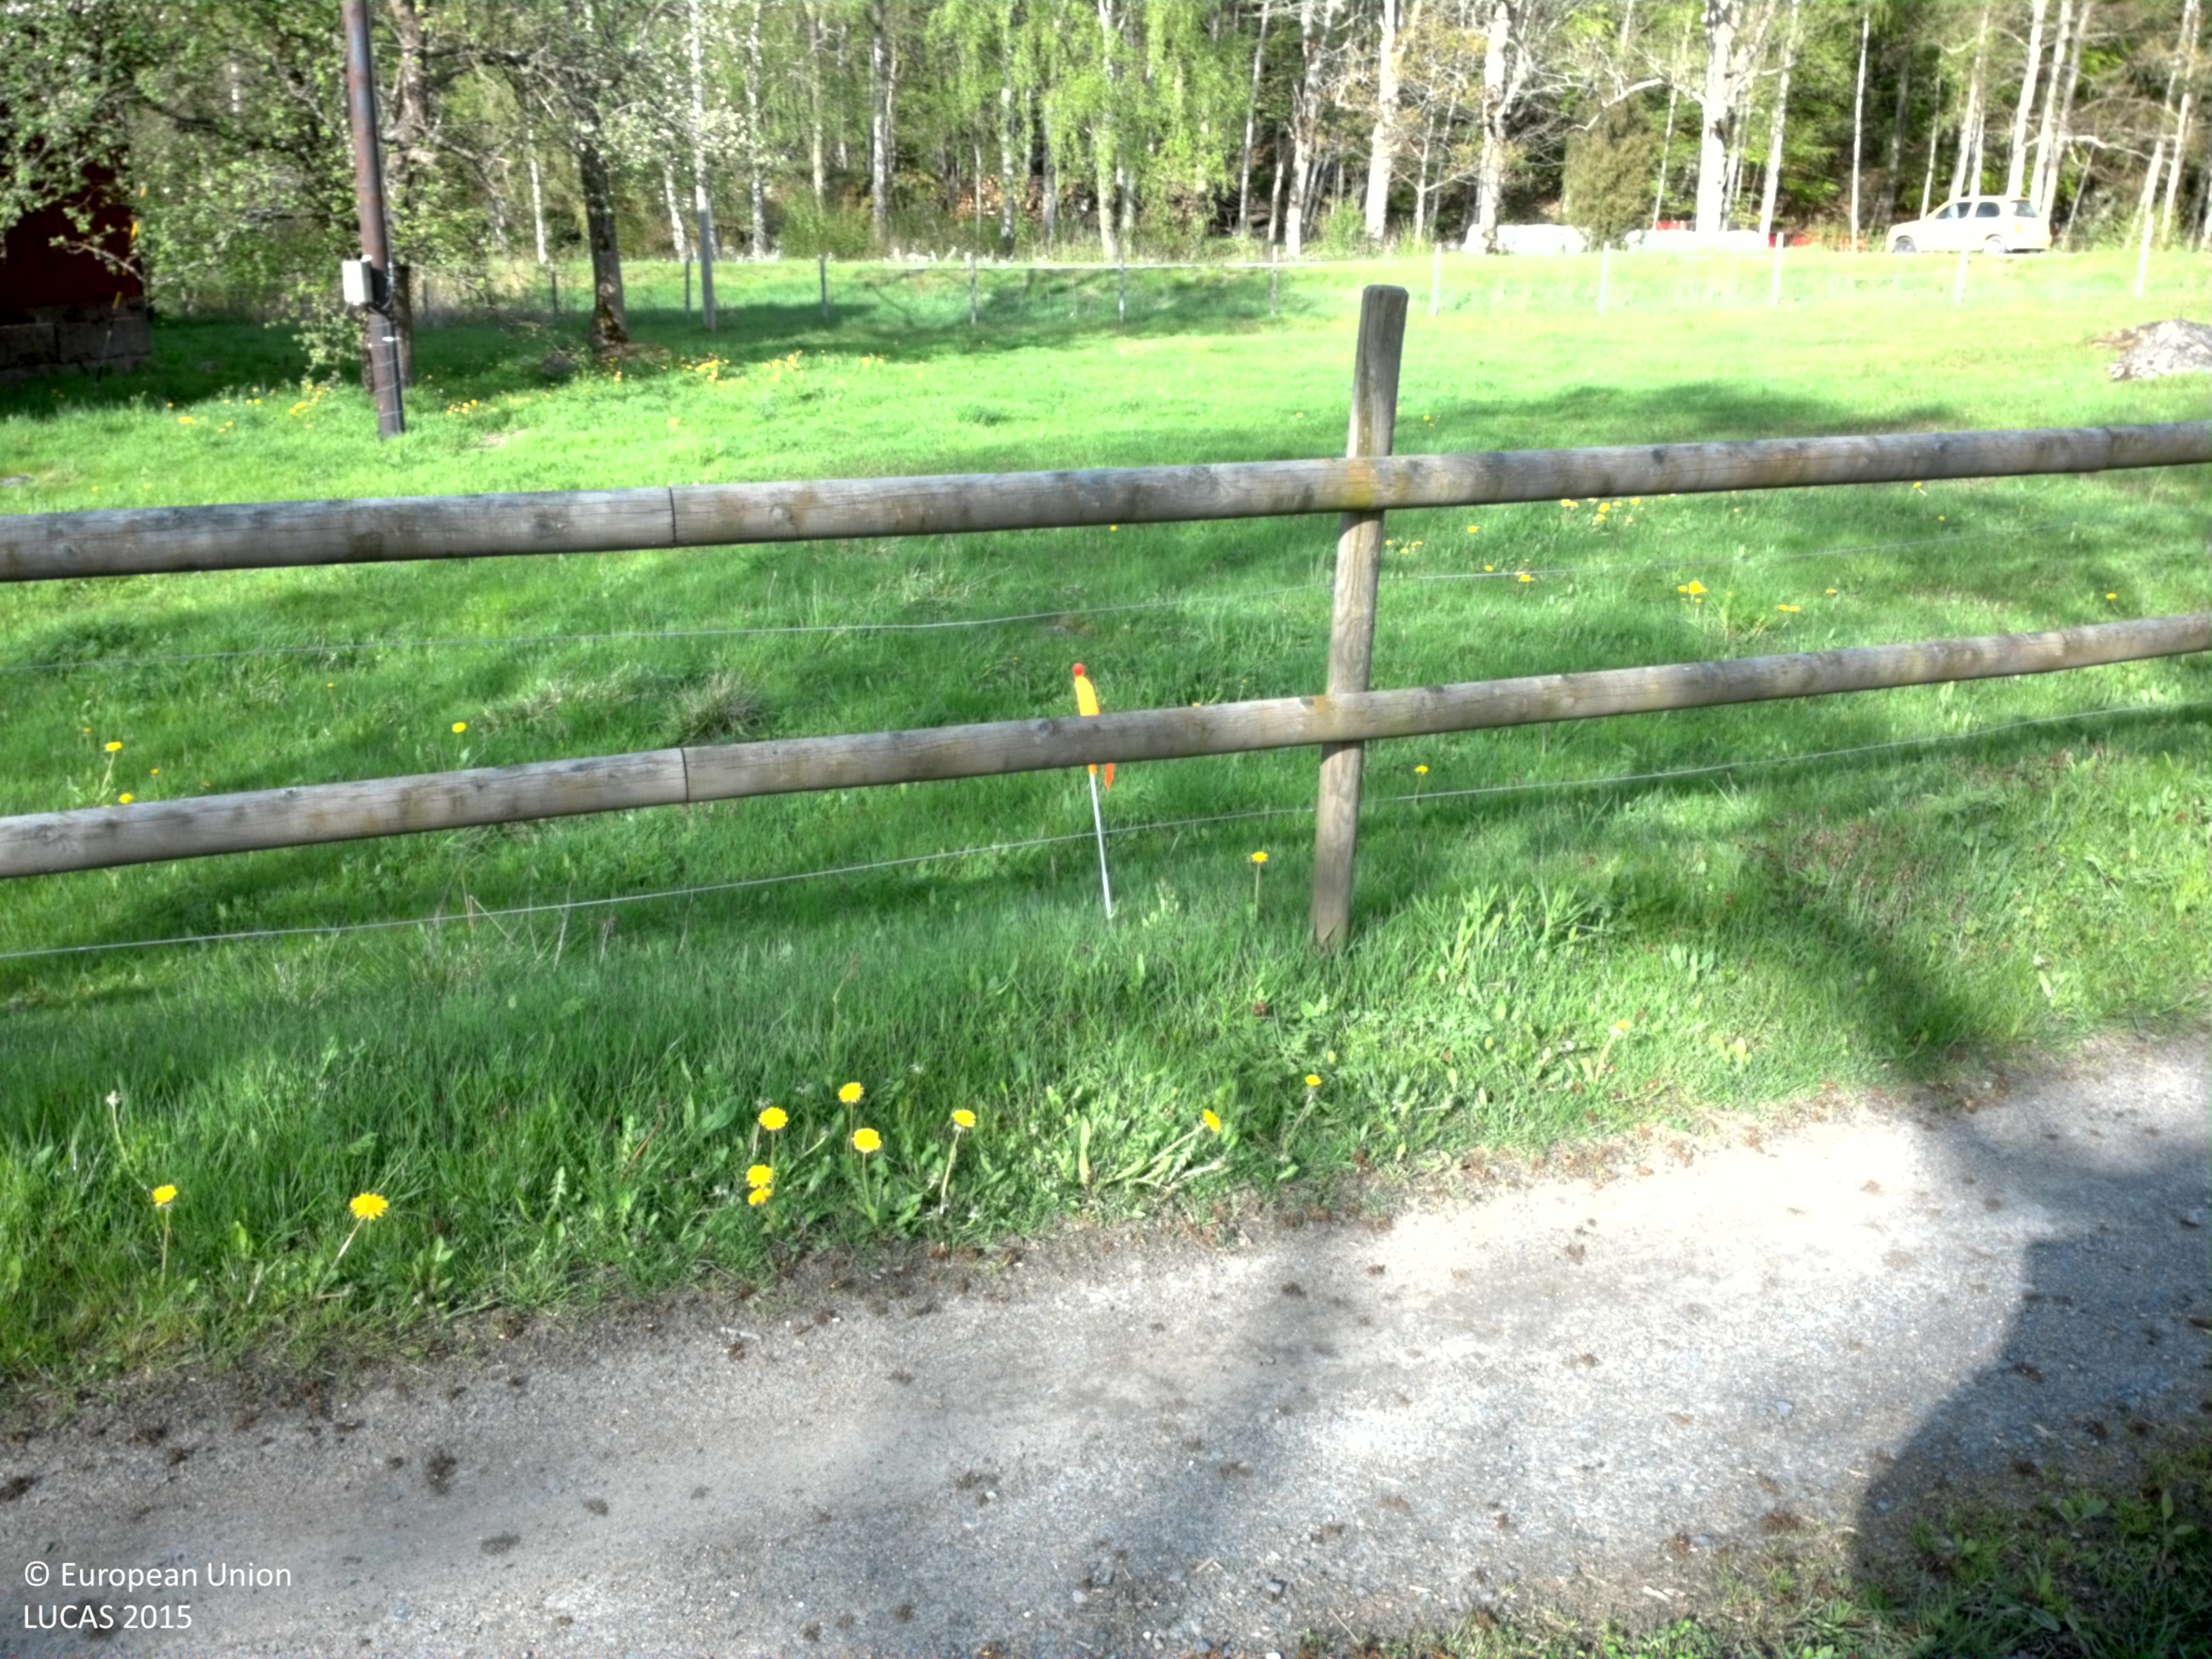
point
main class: Grassland
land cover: Grassland without tree/shrub cover
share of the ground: > 75 %
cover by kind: herbaceous plants 100 %
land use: Agriculture (excluding fallow land and kitchen gardens)
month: May
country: SE
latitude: 56.4028
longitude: 15.2975
